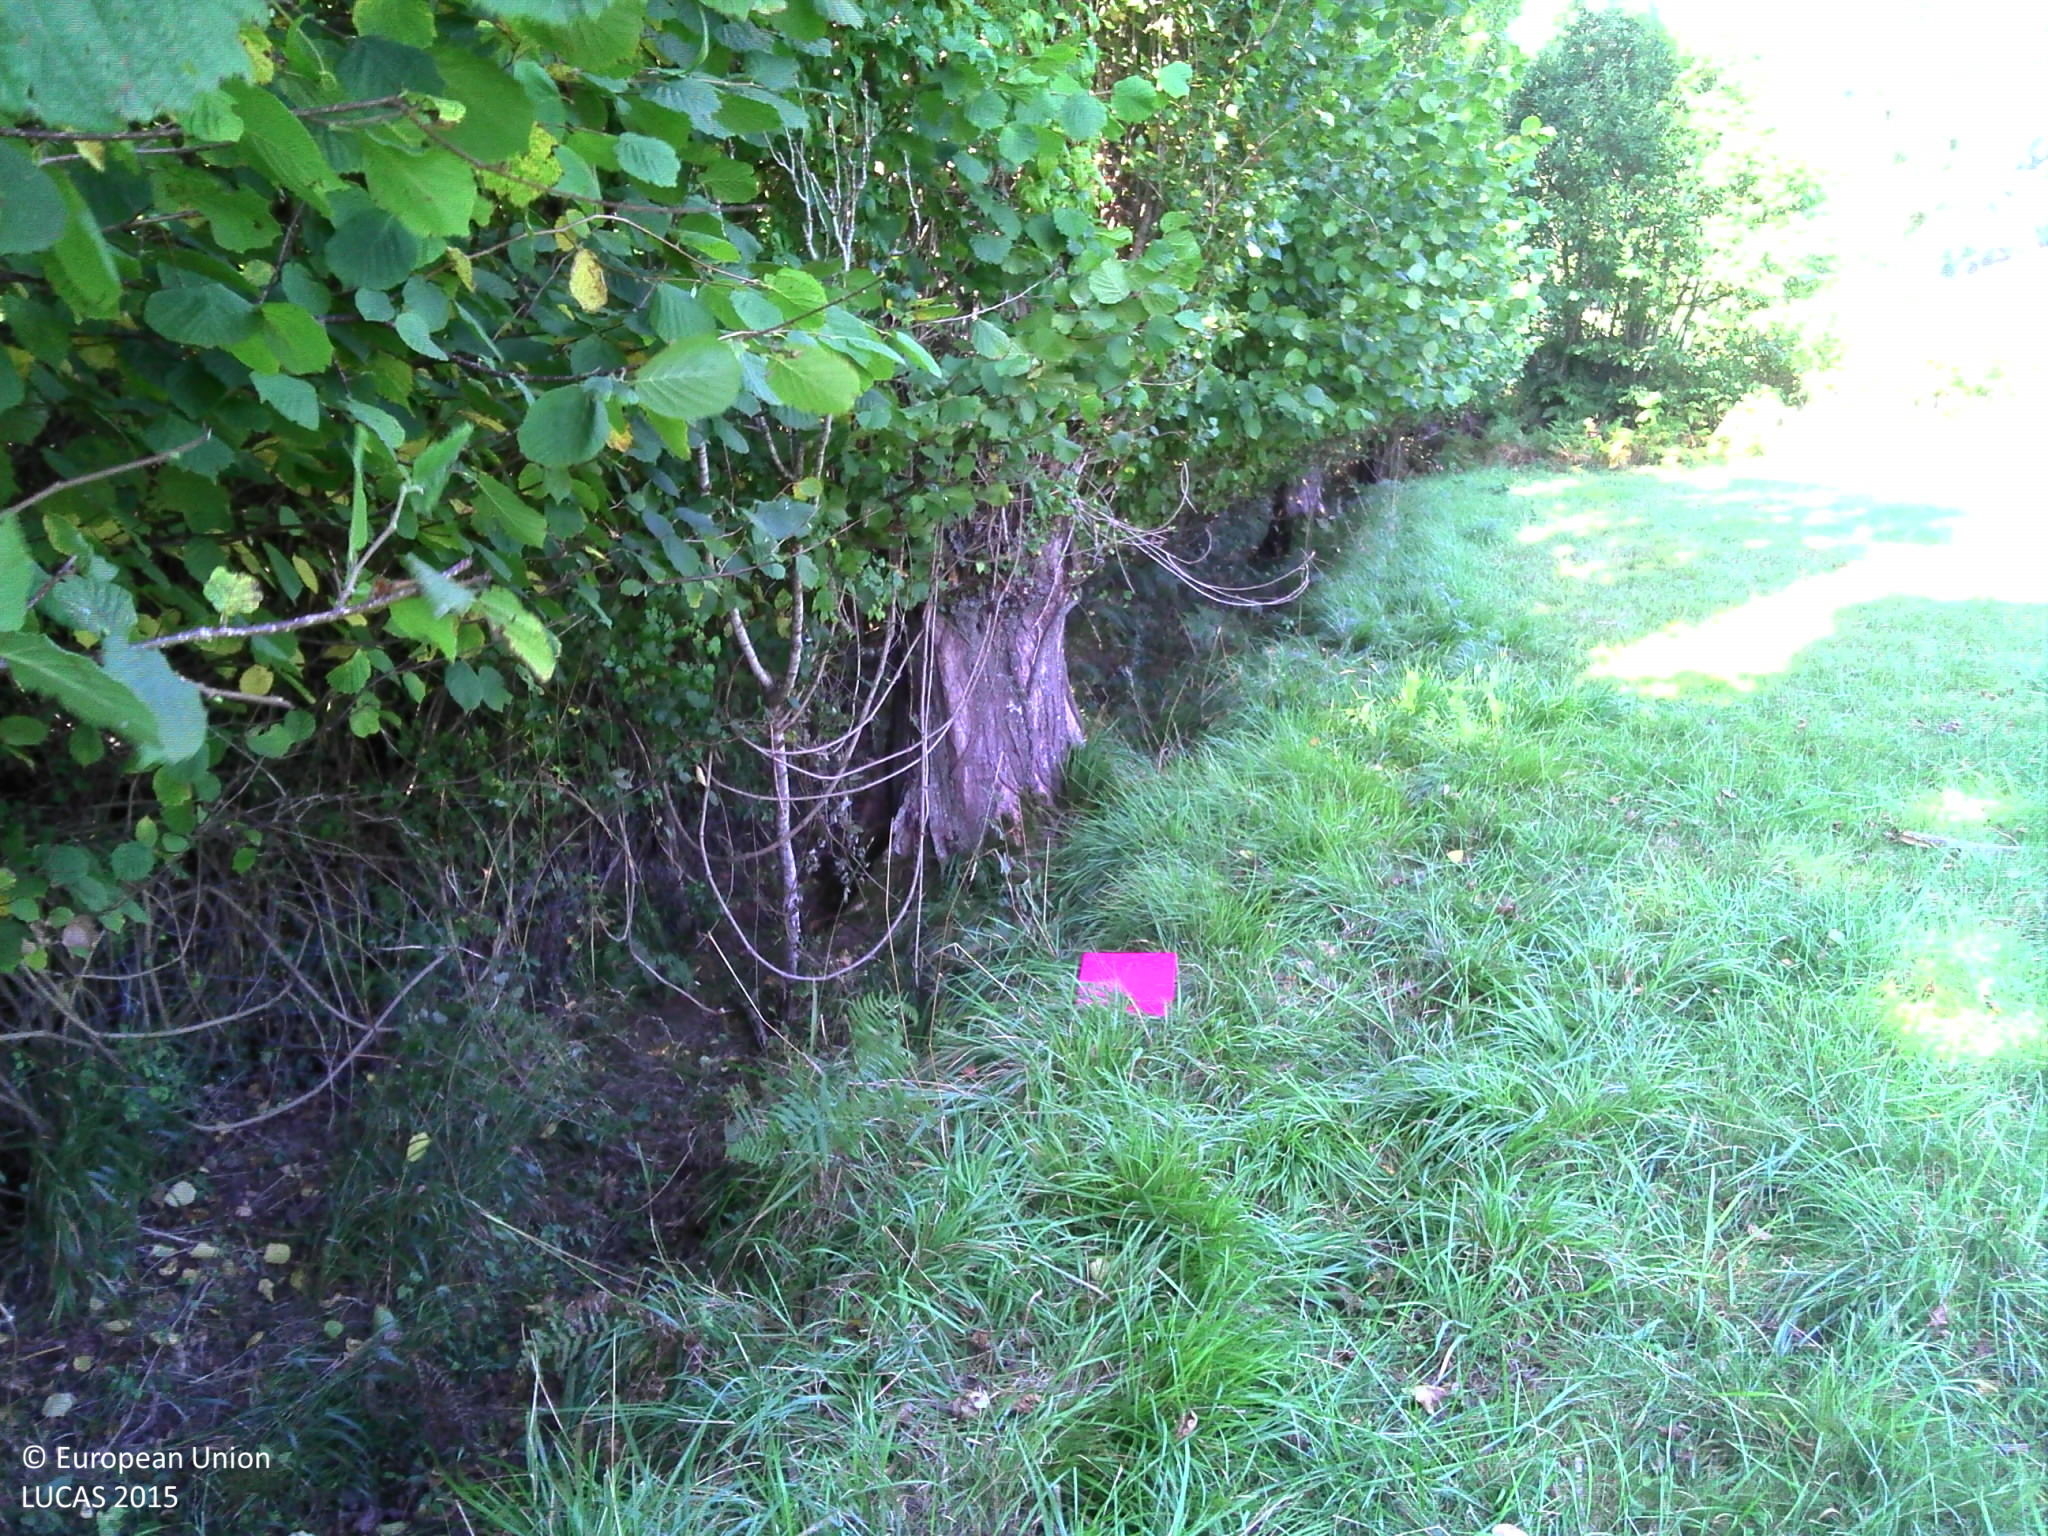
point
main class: Grassland
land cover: Grassland without tree/shrub cover
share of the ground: > 75 %
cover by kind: herbaceous plants 100 %
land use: Agriculture (excluding fallow land and kitchen gardens)
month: September
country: FR
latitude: 43.2453
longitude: -1.0845
